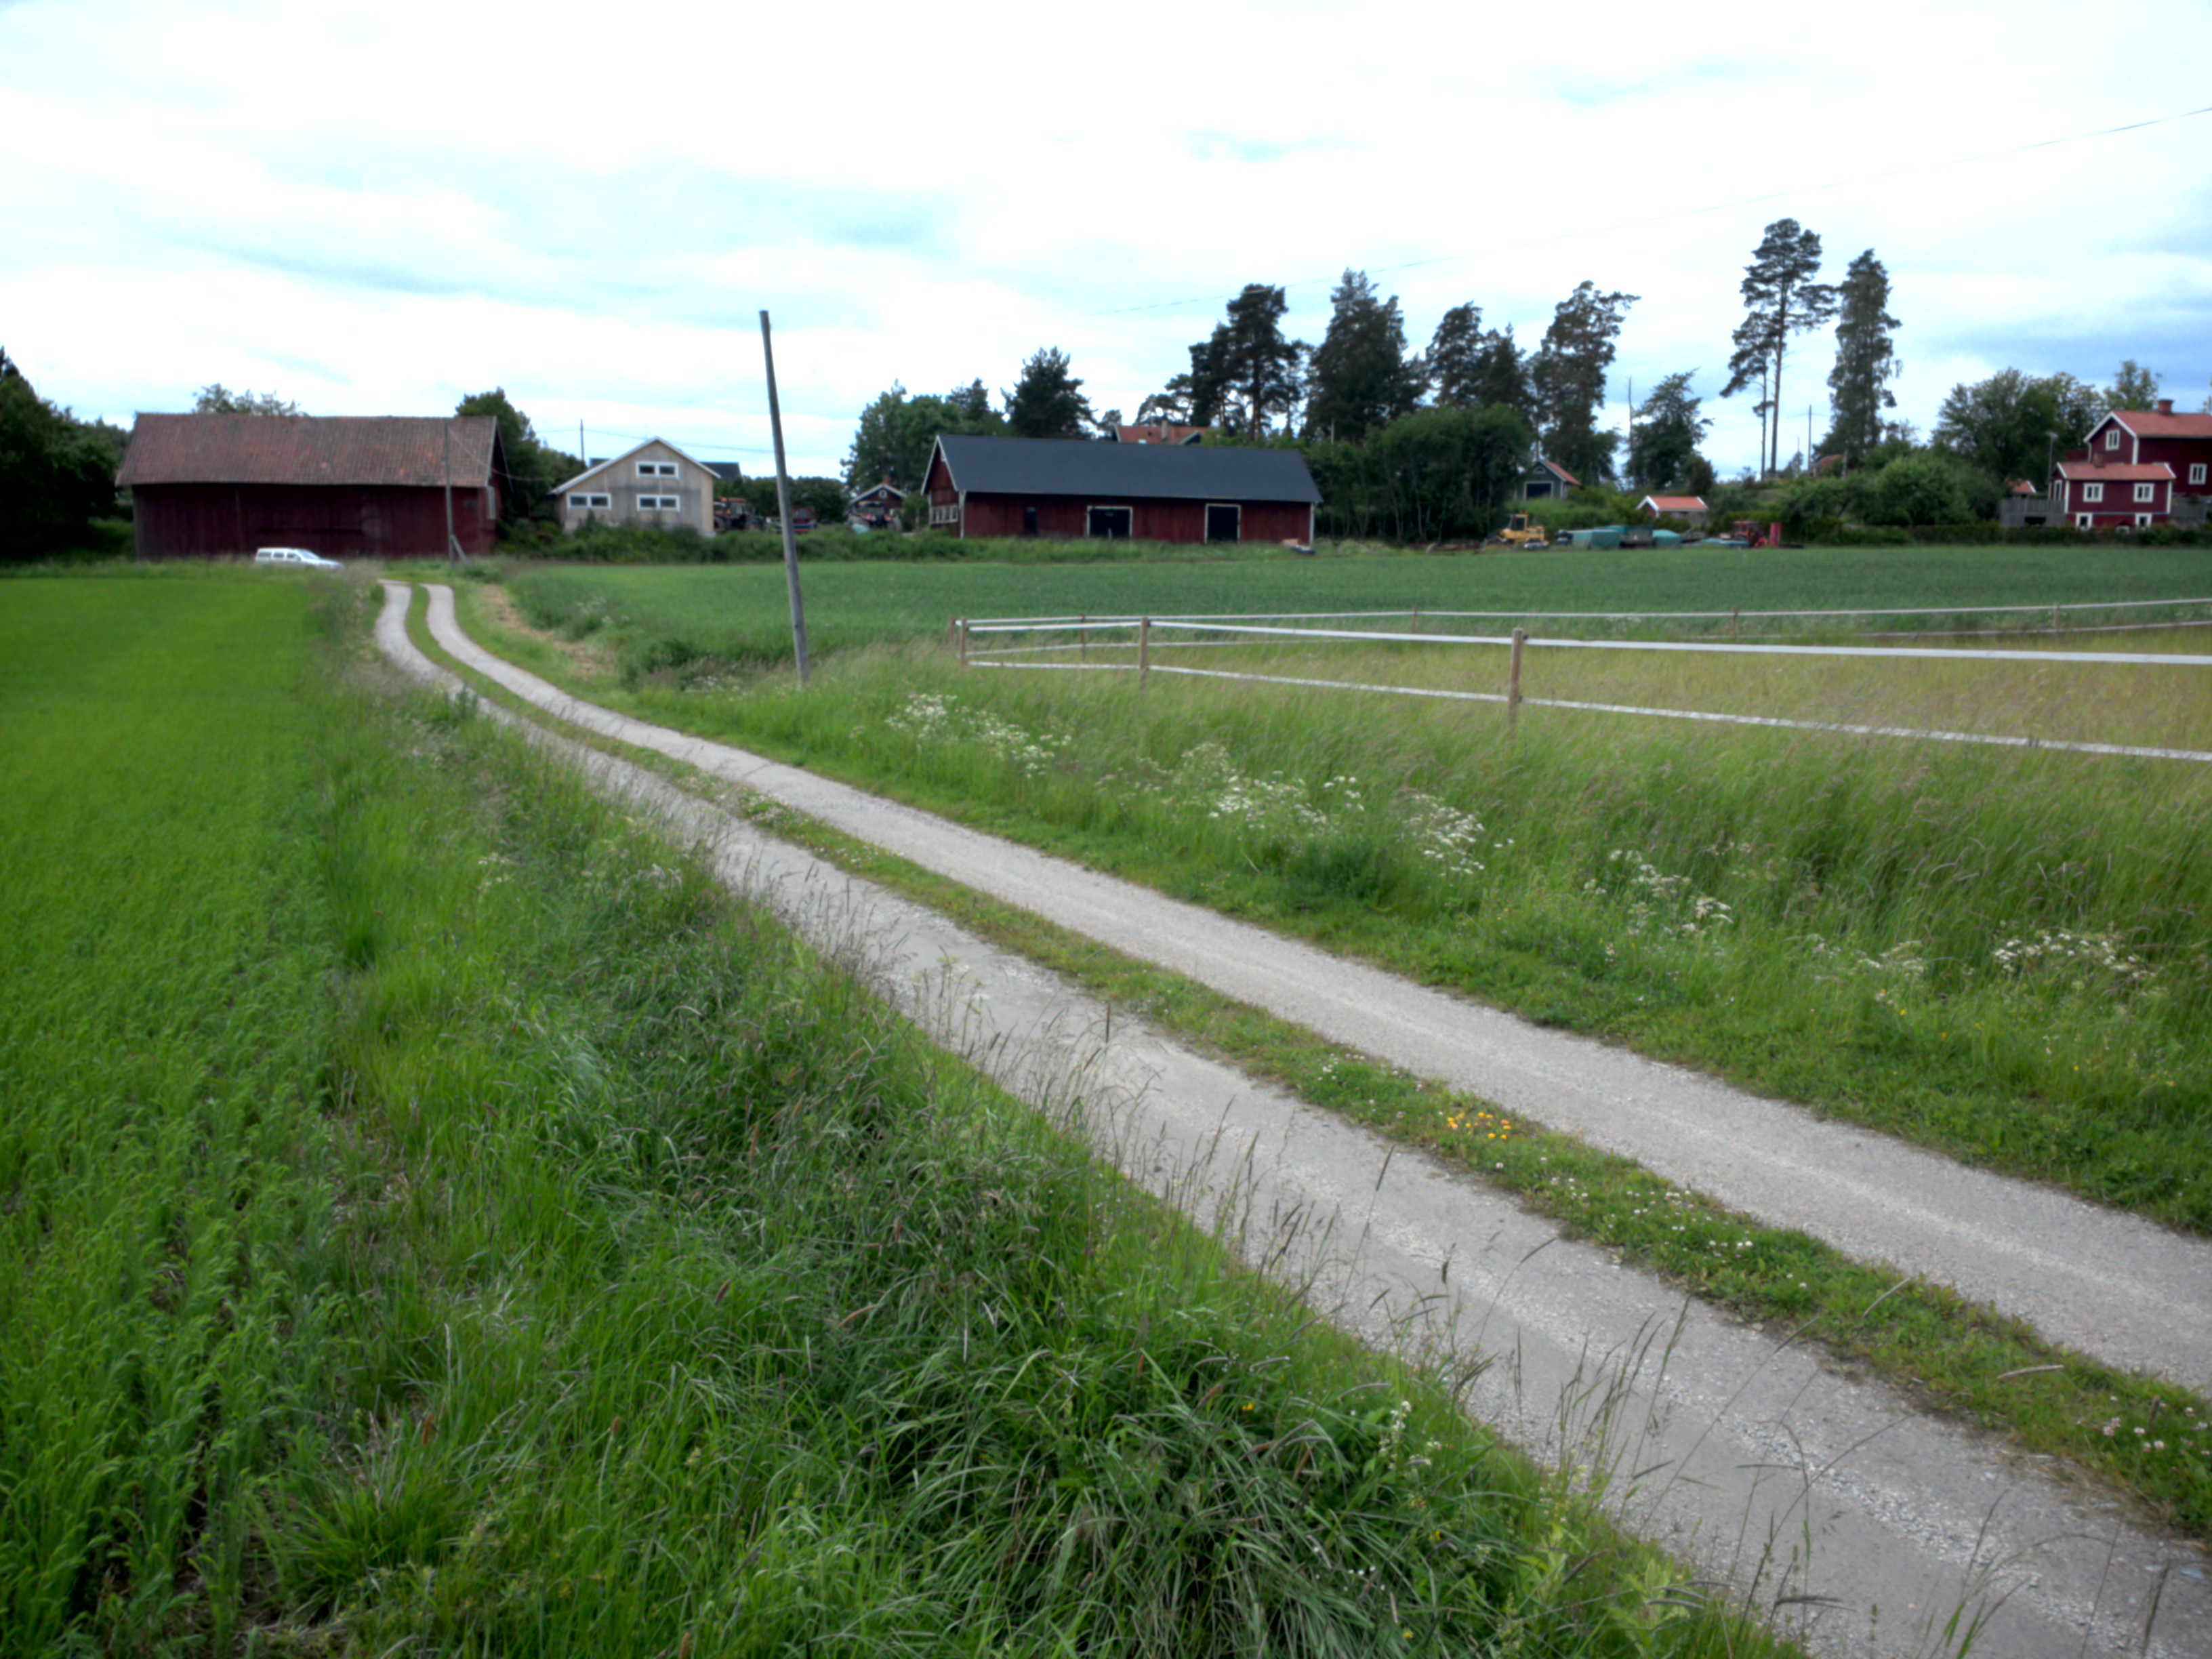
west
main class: Cropland
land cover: Other fibre and oleaginous crops
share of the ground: > 75 %
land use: Agriculture (excluding fallow land and kitchen gardens)
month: June
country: SE
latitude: 59.2780
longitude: 17.4546
